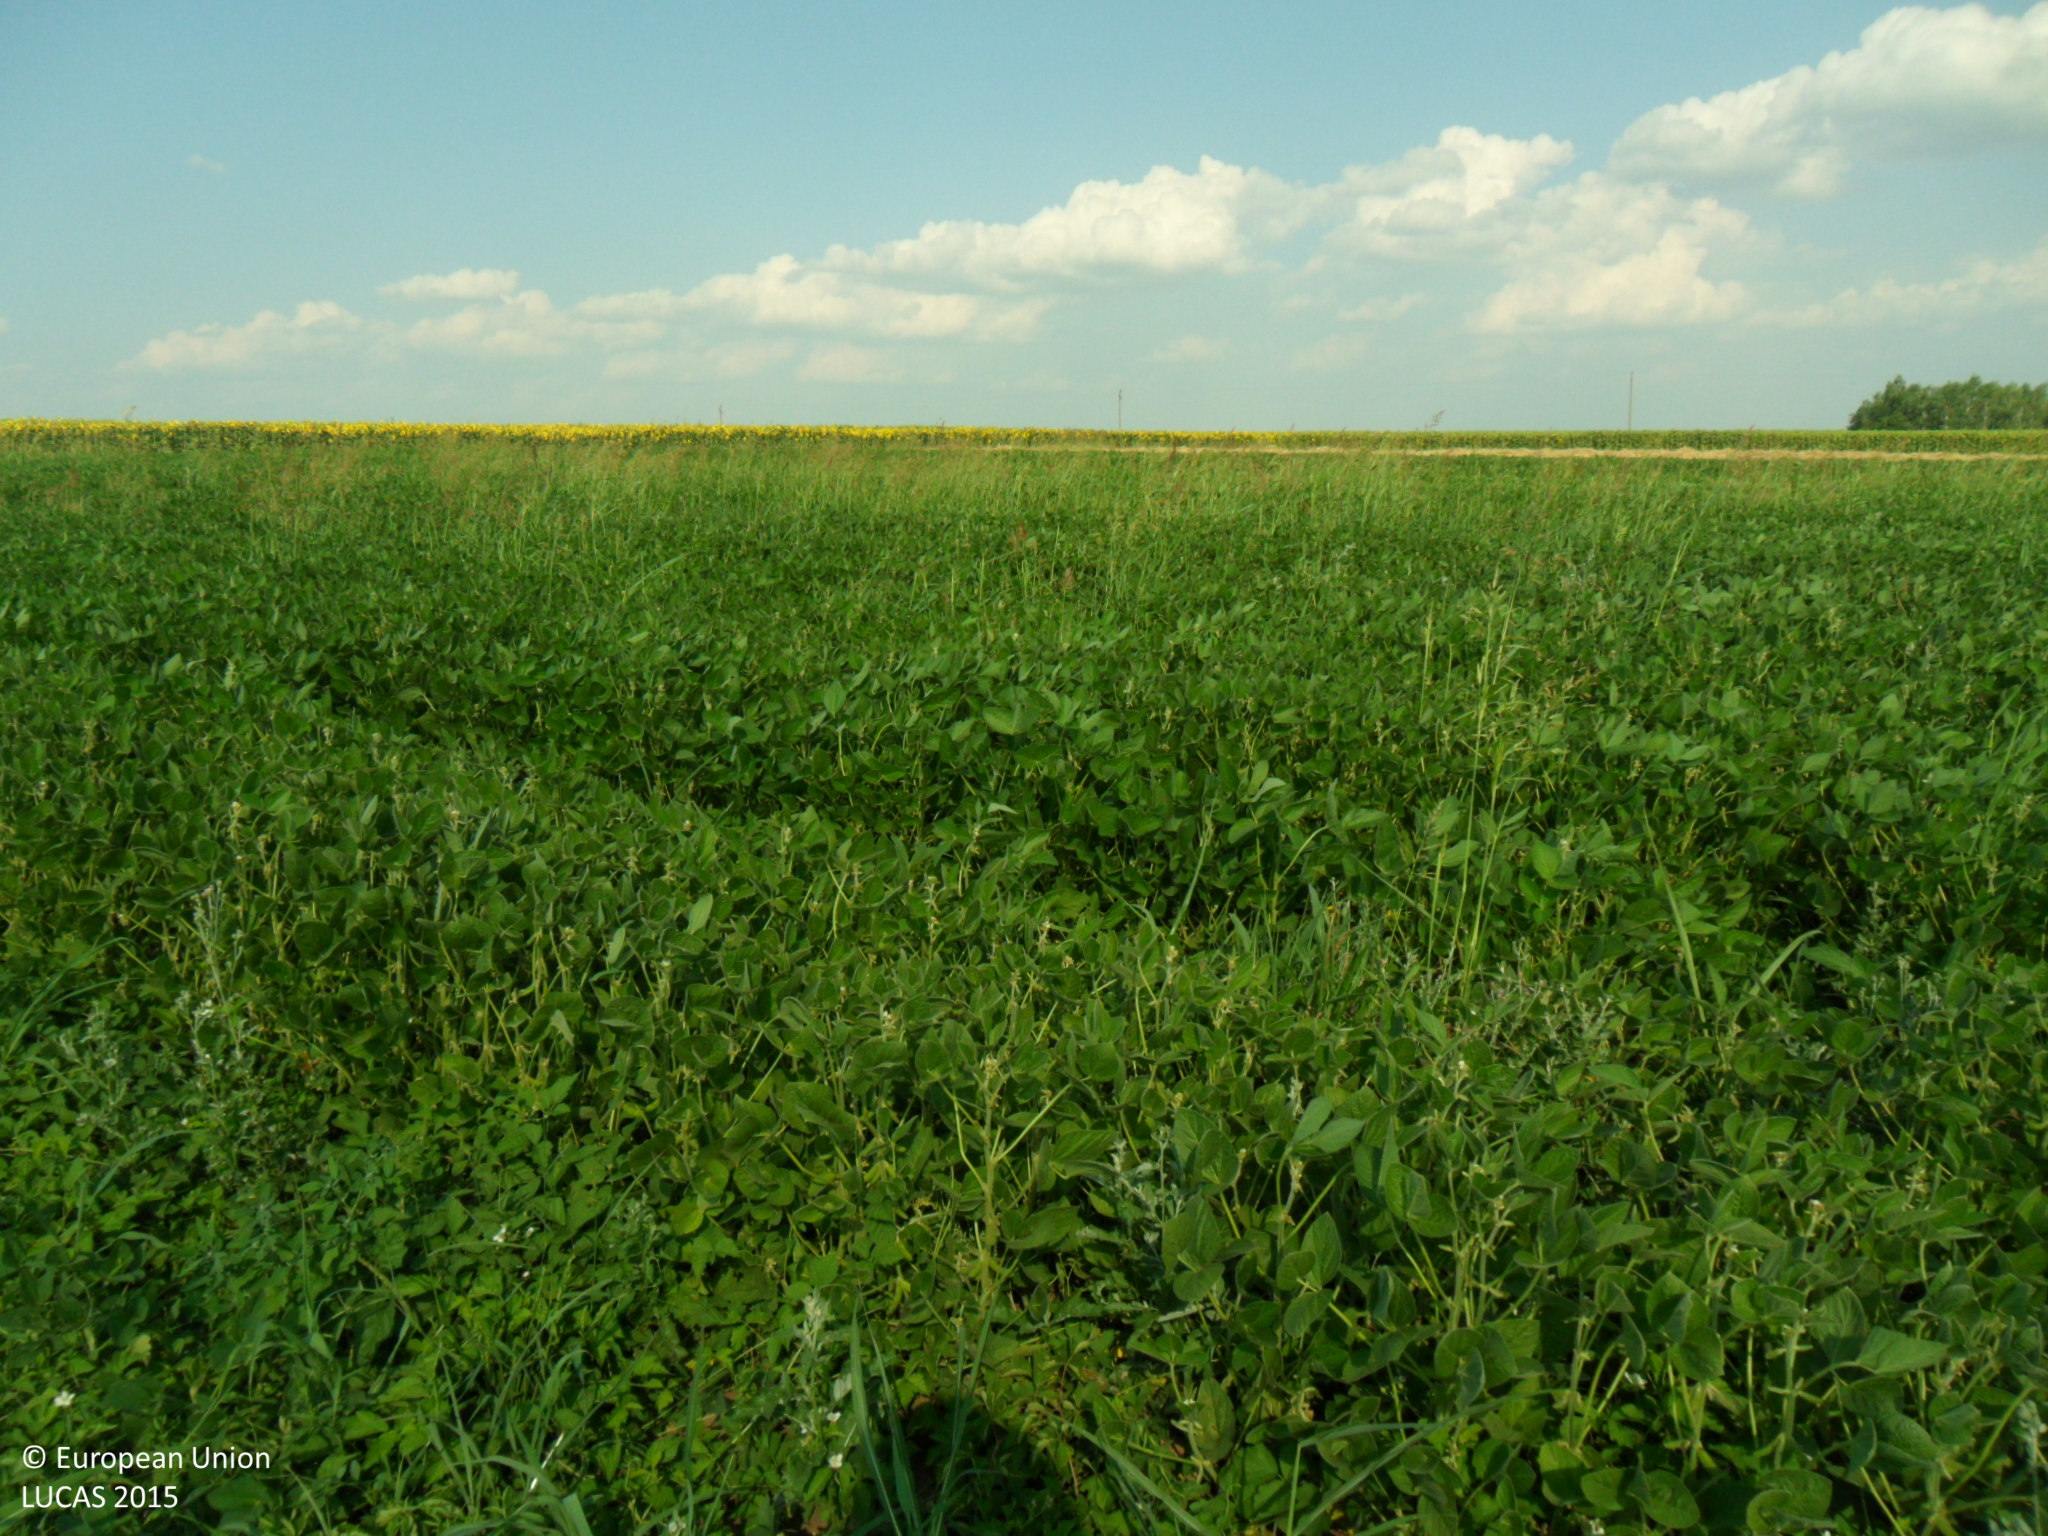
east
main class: Cropland
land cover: Soya
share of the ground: > 75 %
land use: Agriculture (excluding fallow land and kitchen gardens)
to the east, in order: Soya; Common wheat; Grass margins; Tracks; Grass margins; Sunflower
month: July
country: BG
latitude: 43.6592
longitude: 27.0722
